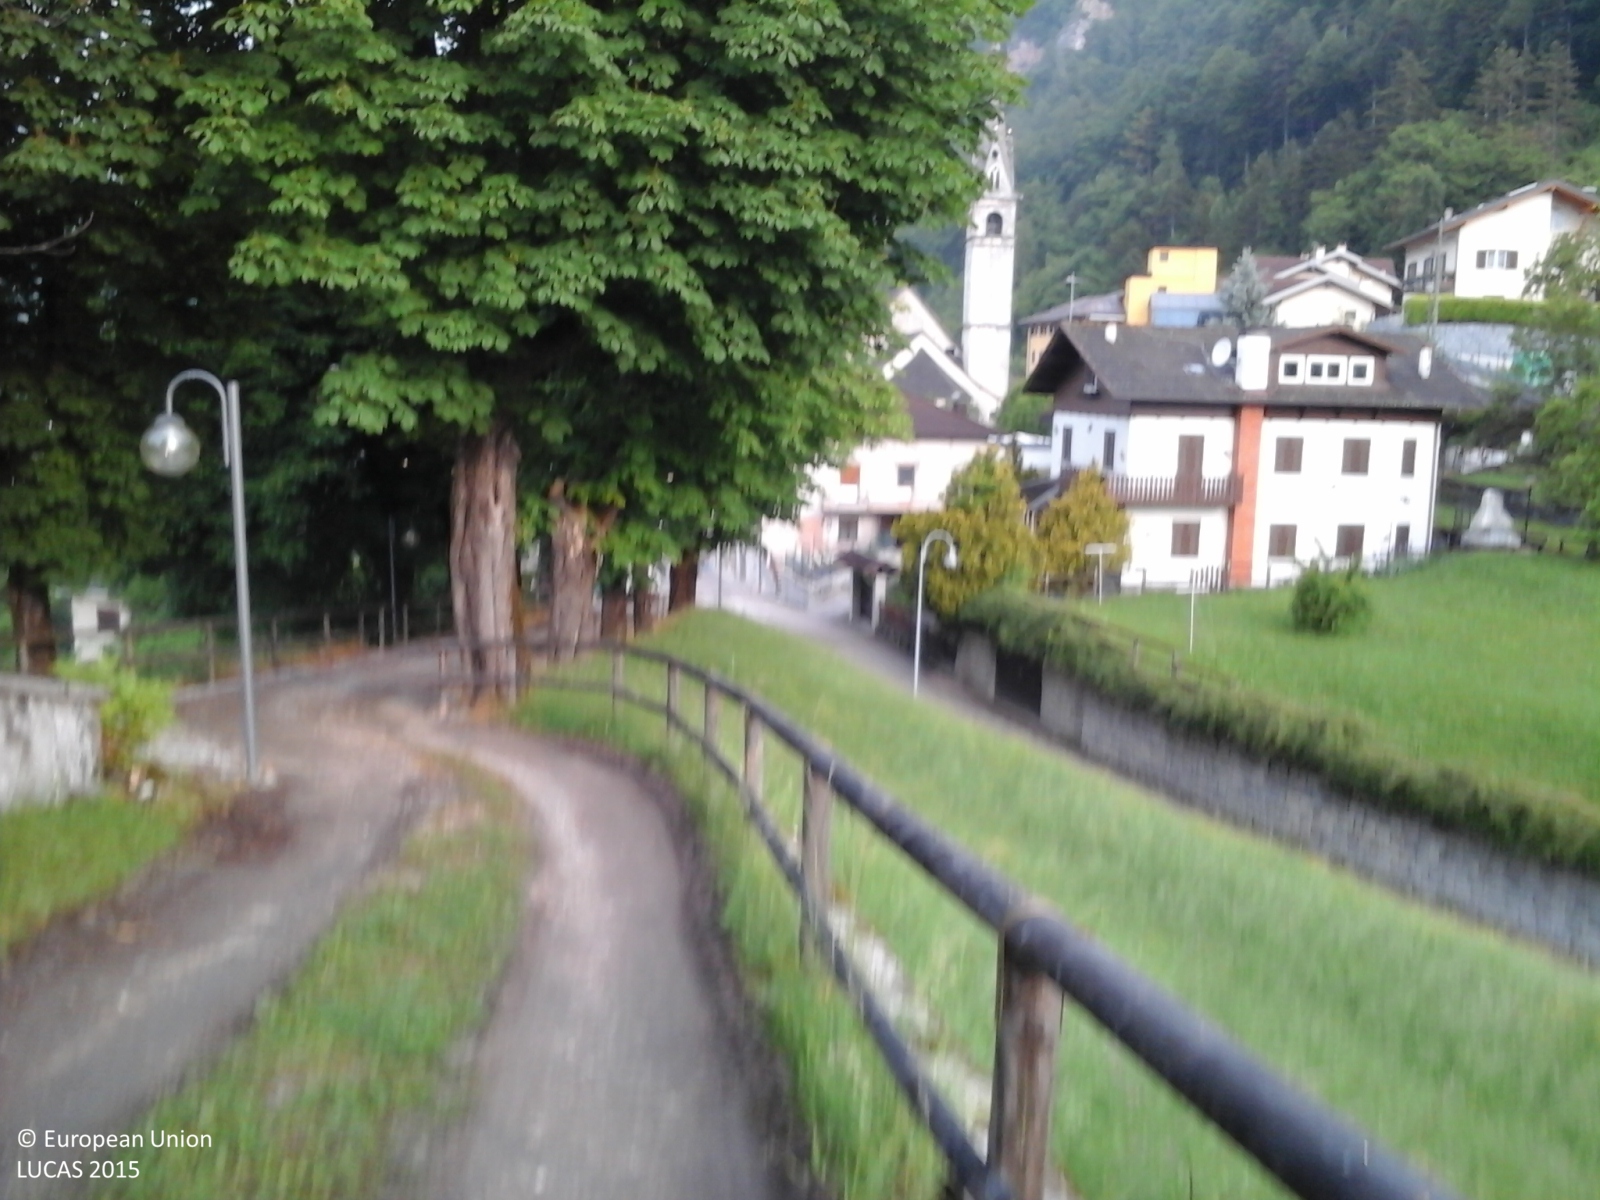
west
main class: Grassland
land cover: Grassland without tree/shrub cover
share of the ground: > 75 %
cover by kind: herbaceous plants 90 %, consolidated bare surface 5 %, unconsolidated bare surface 5 %
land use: Agriculture (excluding fallow land and kitchen gardens)
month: May
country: IT
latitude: 46.0688
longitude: 11.6138
